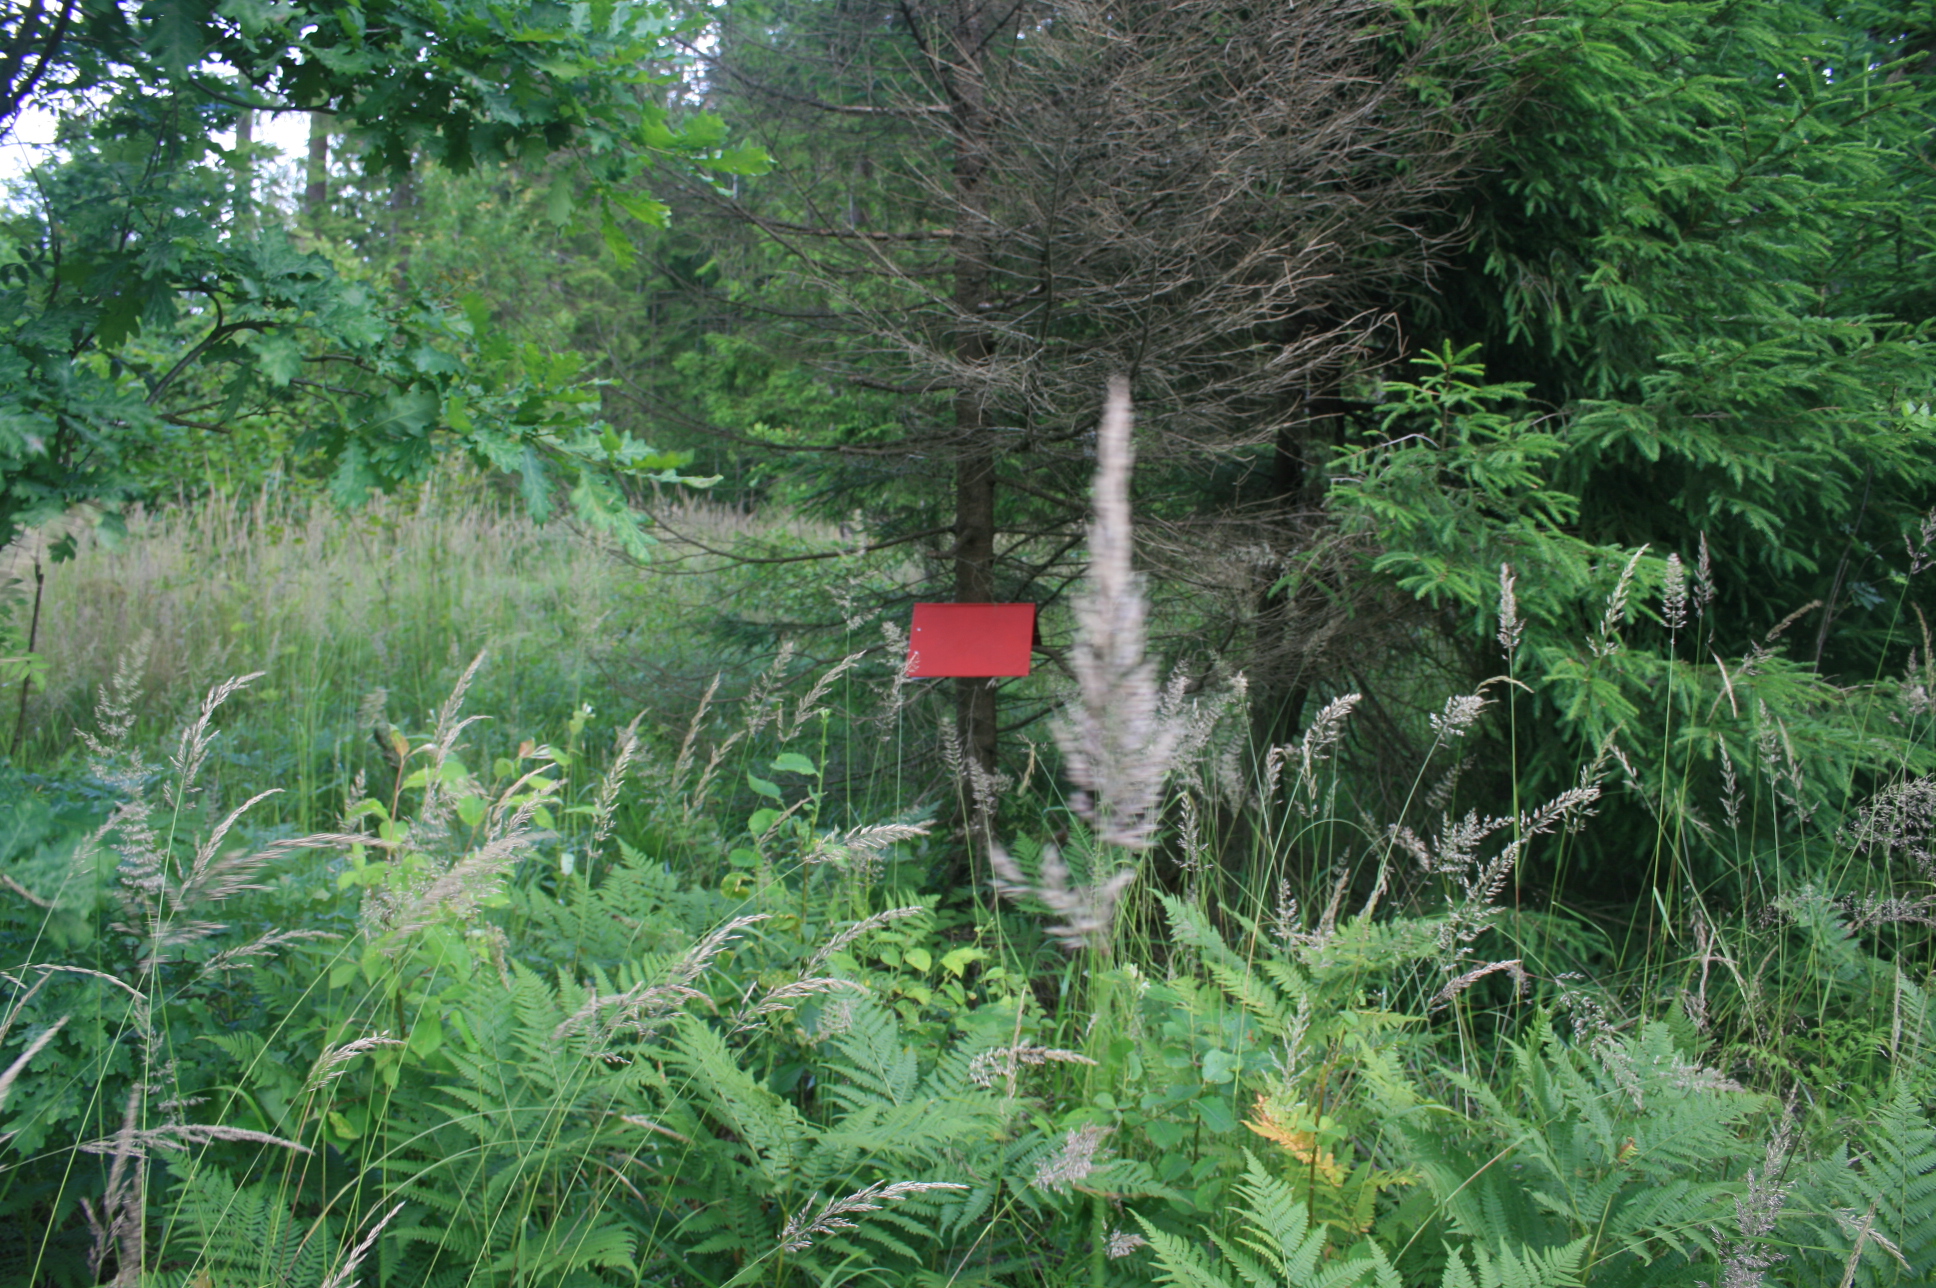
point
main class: Woodland
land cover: Spruce dominated mixed woodland
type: hemiboreal forest and nemoral coniferous forest and mixed broadleaved-coniferous forest
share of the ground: 50 - 75 %
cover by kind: coniferous forest trees 45 %, herbaceous plants 30 %, broadleaved forest trees 25 %
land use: Forestry
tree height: > 5 m
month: July
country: LT
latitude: 55.8268
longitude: 21.3608
